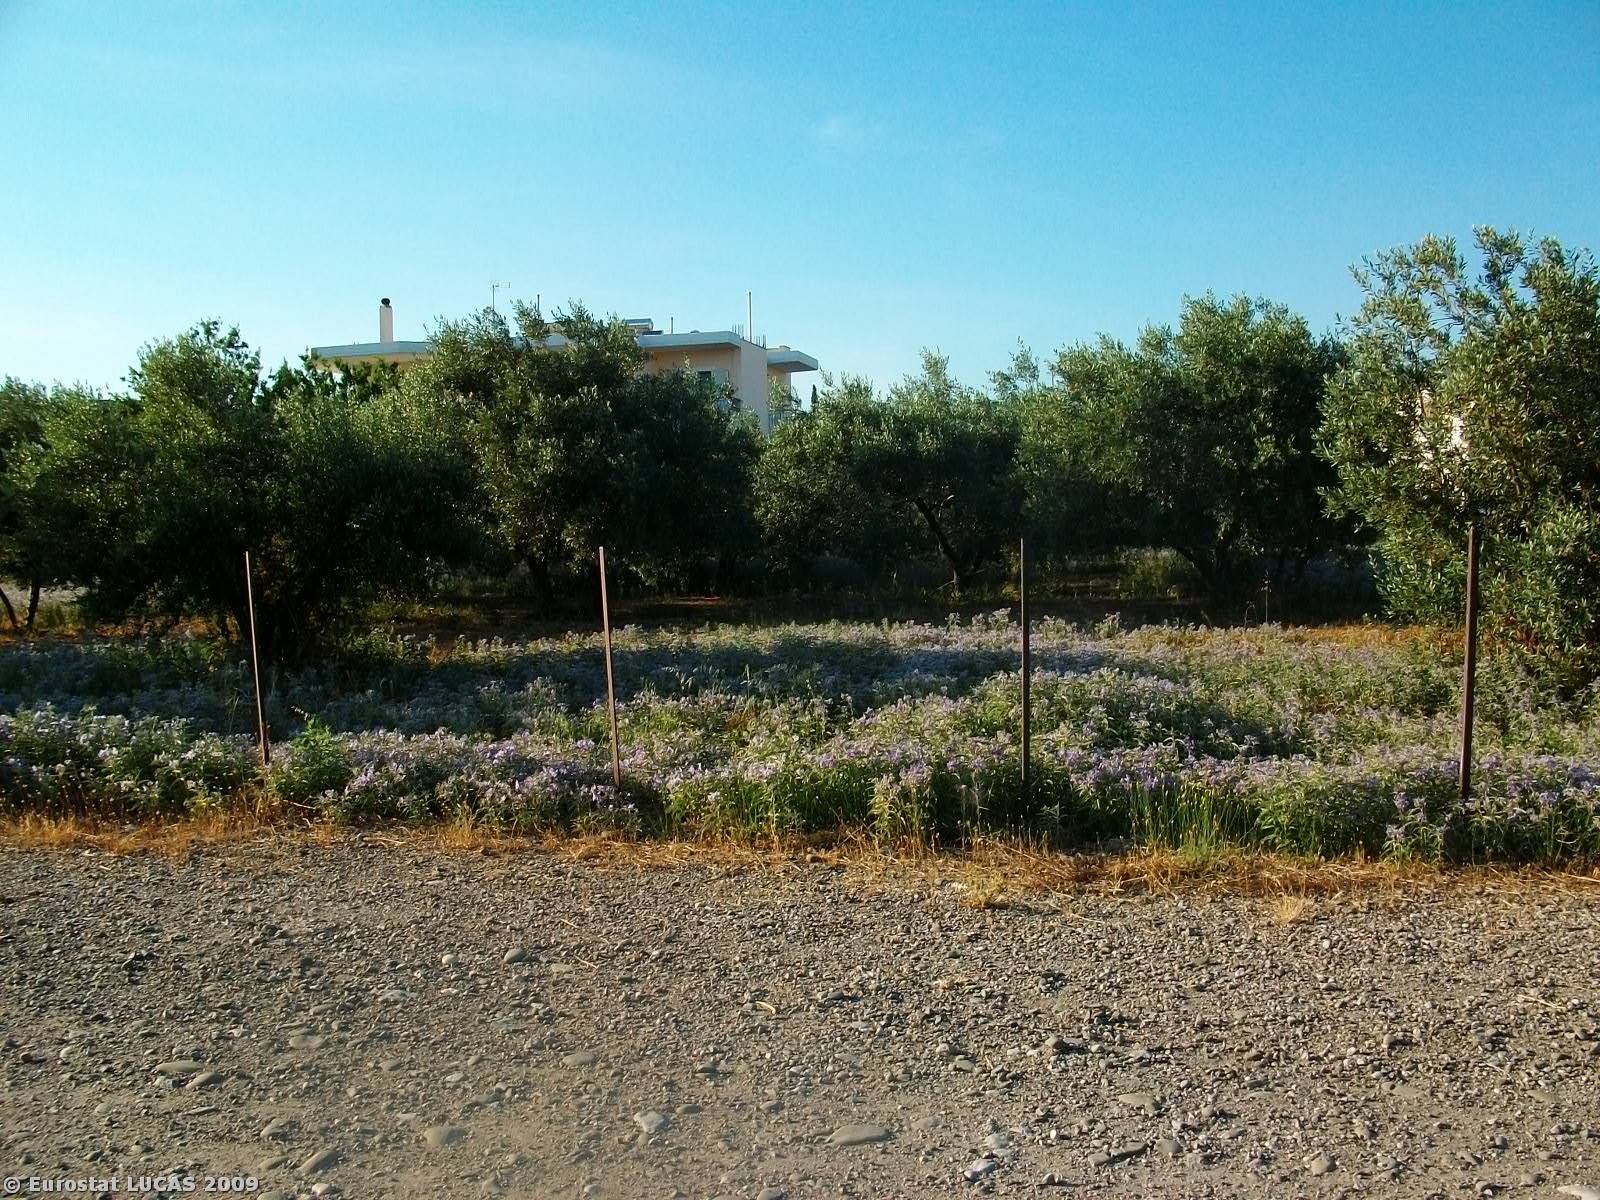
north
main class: Grassland
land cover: Grassland without tree/shrub cover
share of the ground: > 75 %
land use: Unused
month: June
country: GR
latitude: 38.8865
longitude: 22.4427
